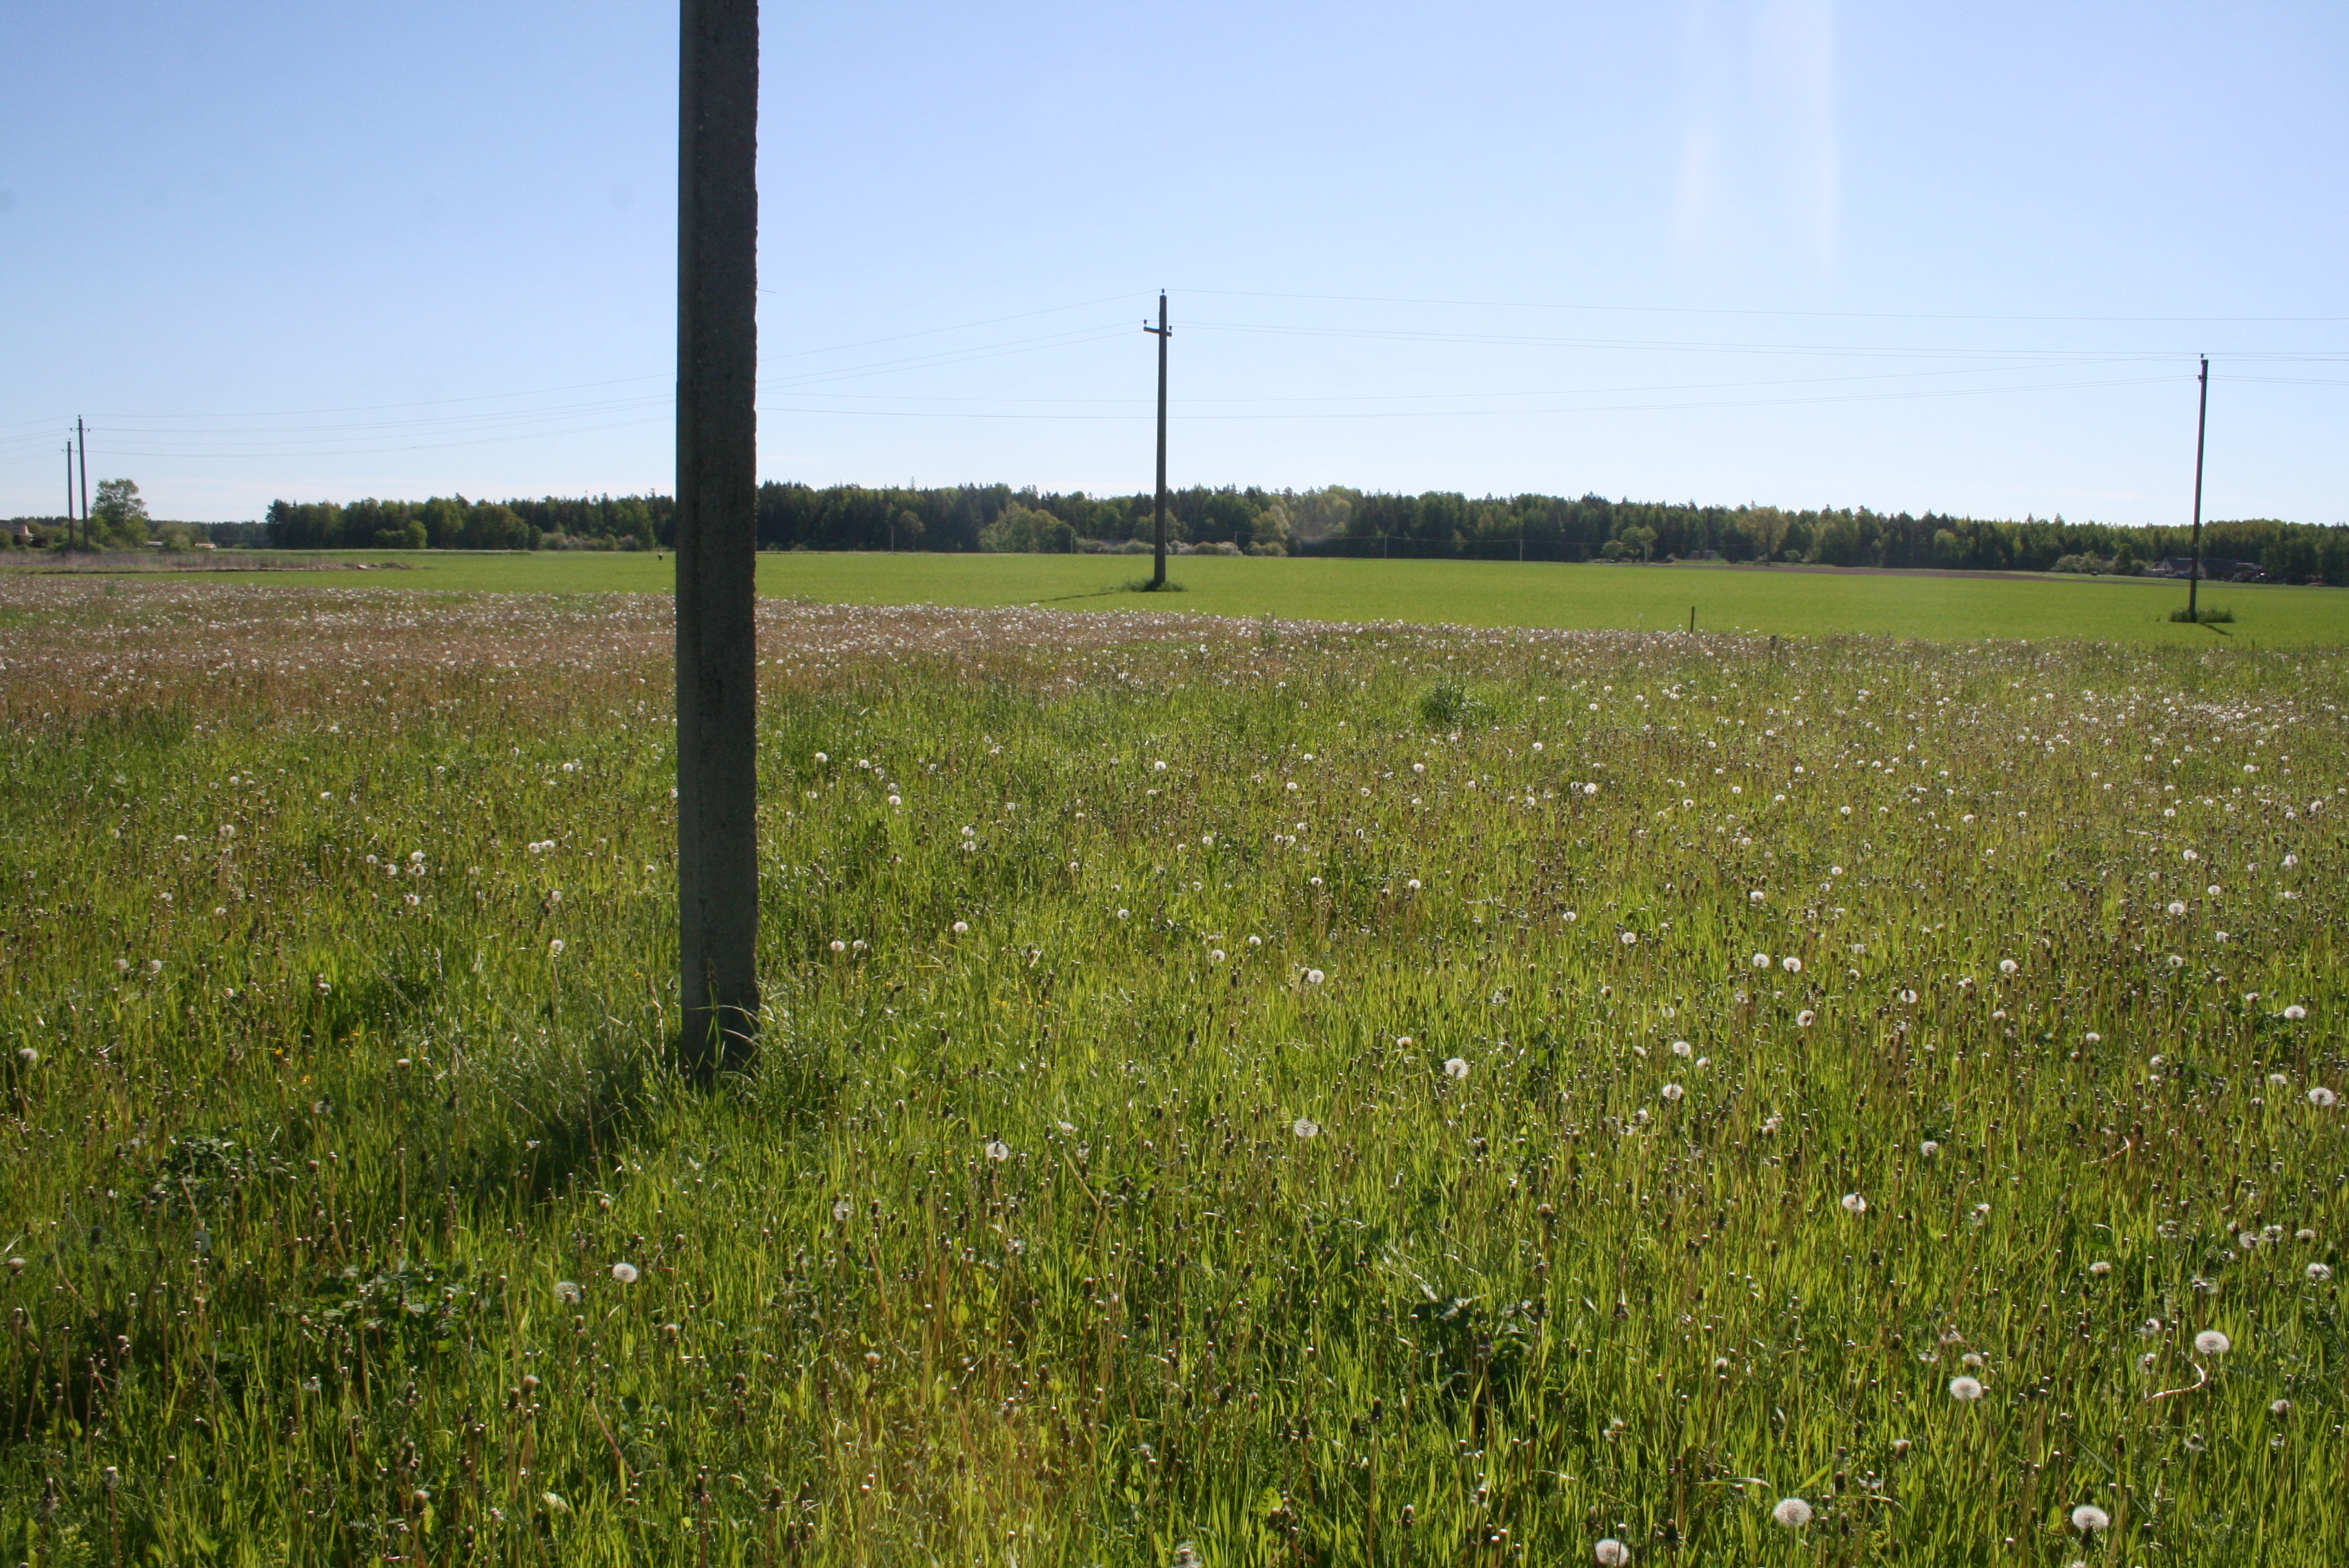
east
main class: Grassland
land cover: Grassland without tree/shrub cover
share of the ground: > 75 %
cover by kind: herbaceous plants 100 %
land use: Agriculture (excluding fallow land and kitchen gardens)
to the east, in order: Grassland without tree/shrub cover; Electric lines; Grassland without tree/shrub cover; Barley; Electric lines; Barley; Electric lines; Barley
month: May
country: LT
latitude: 56.2485
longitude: 22.3043
